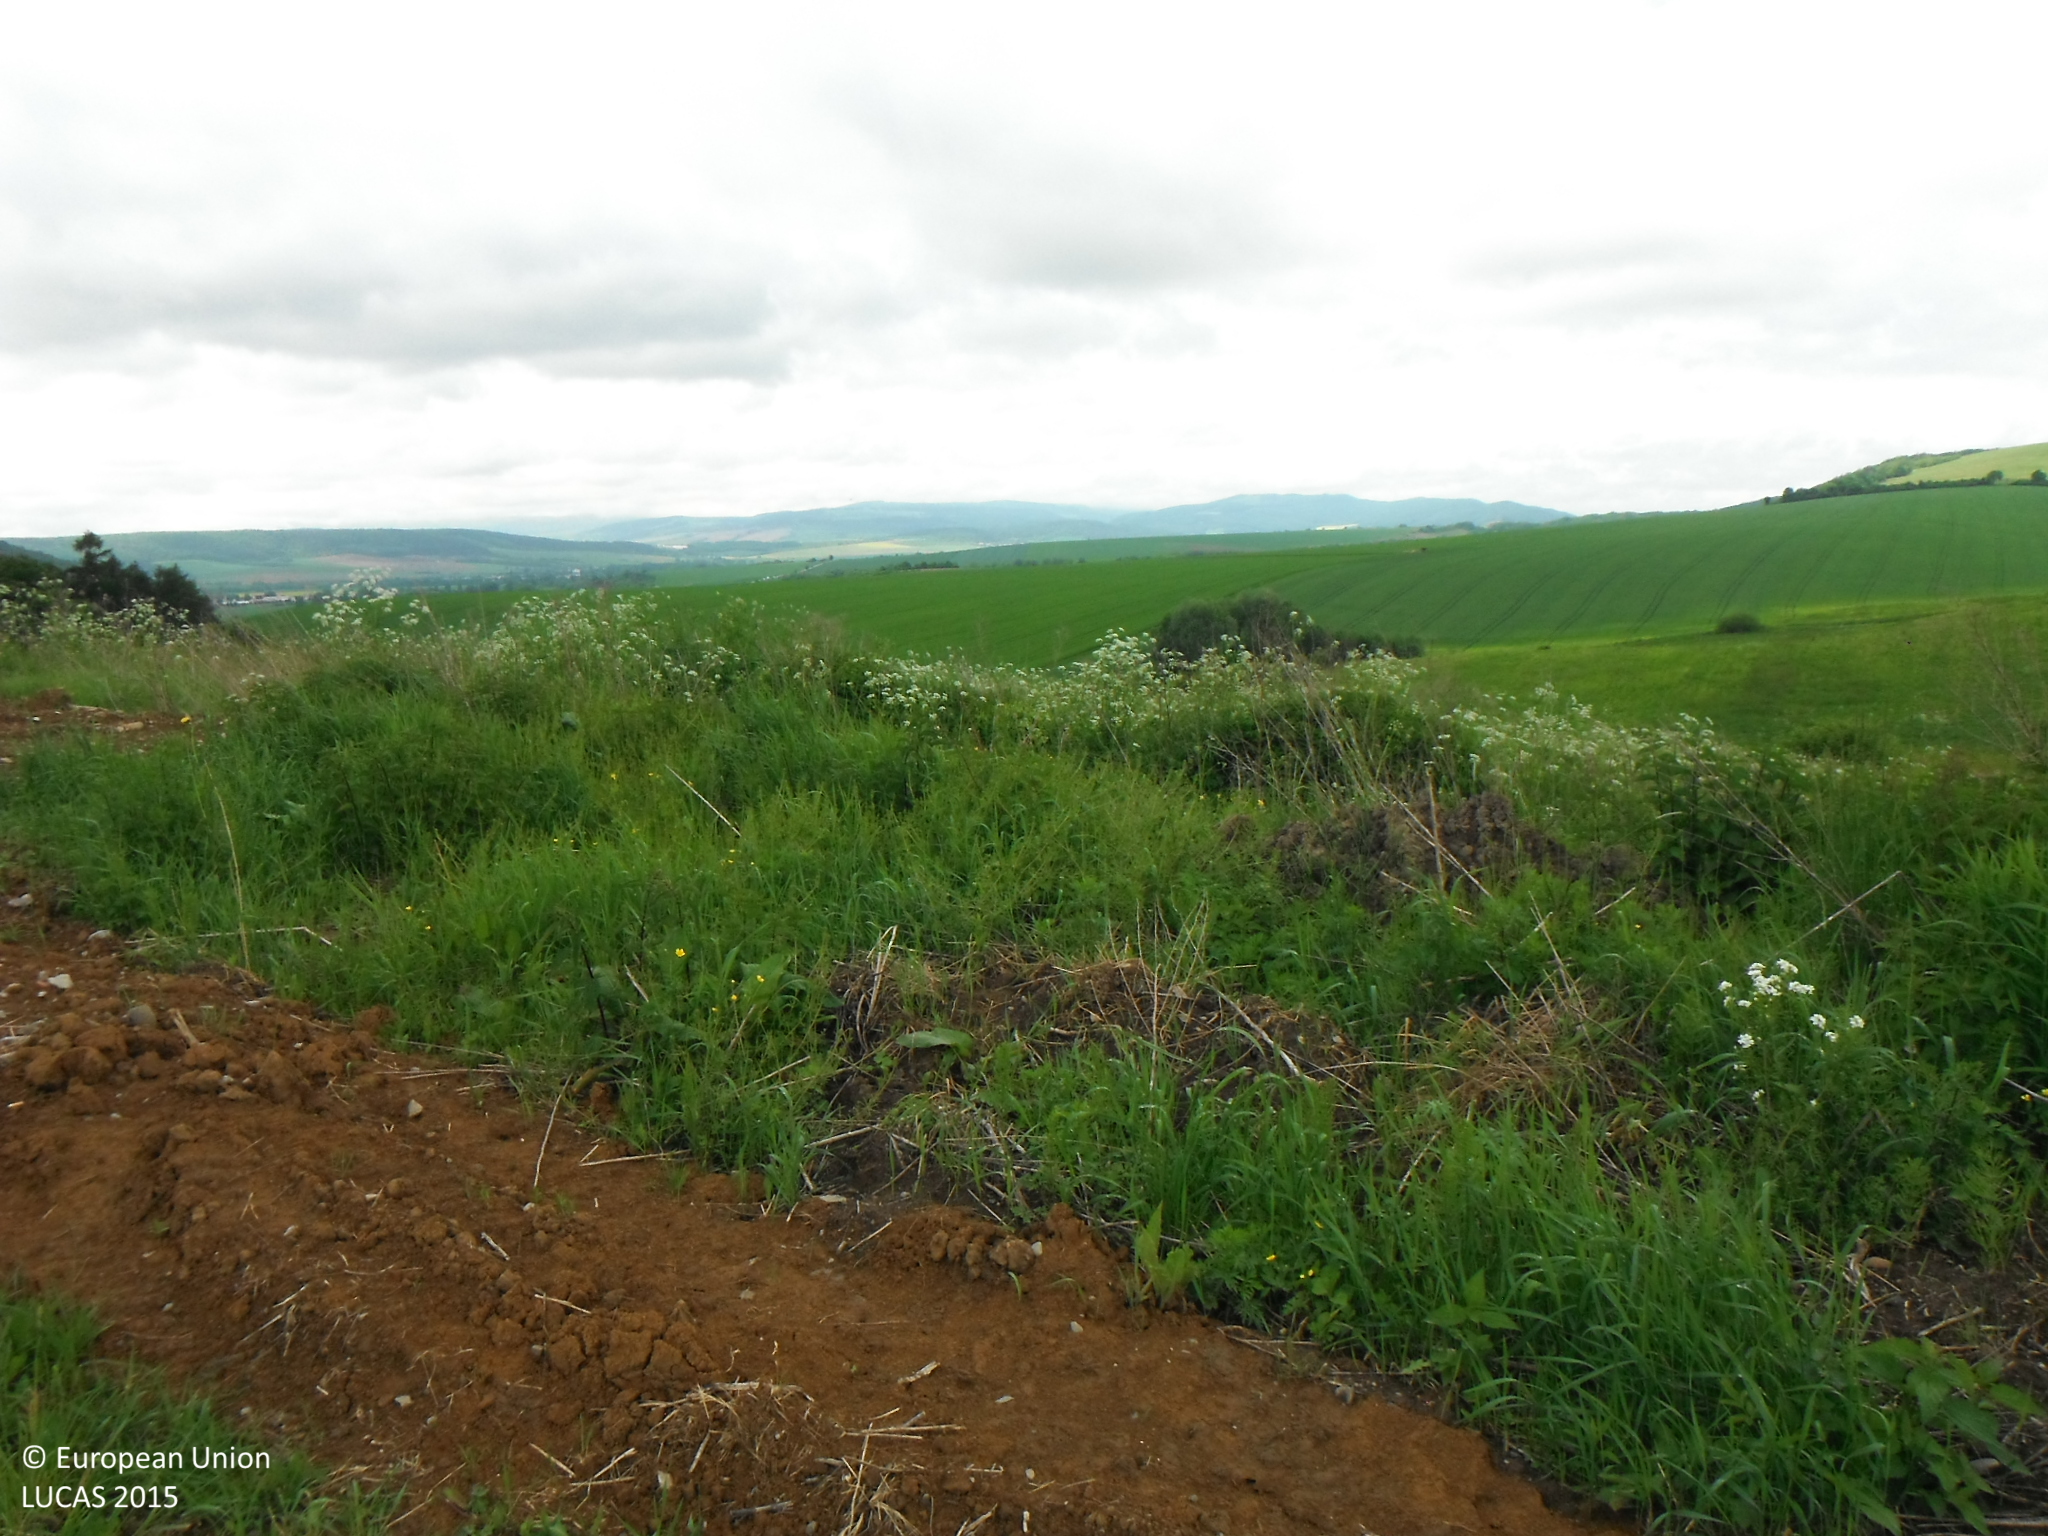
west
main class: Artificial land
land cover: Non built-up linear features
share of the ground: > 75 %
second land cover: Spontaneously vegetated surfaces
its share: 25 - 50 %
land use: Road transport
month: May
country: SK
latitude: 49.0675
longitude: 21.1999
